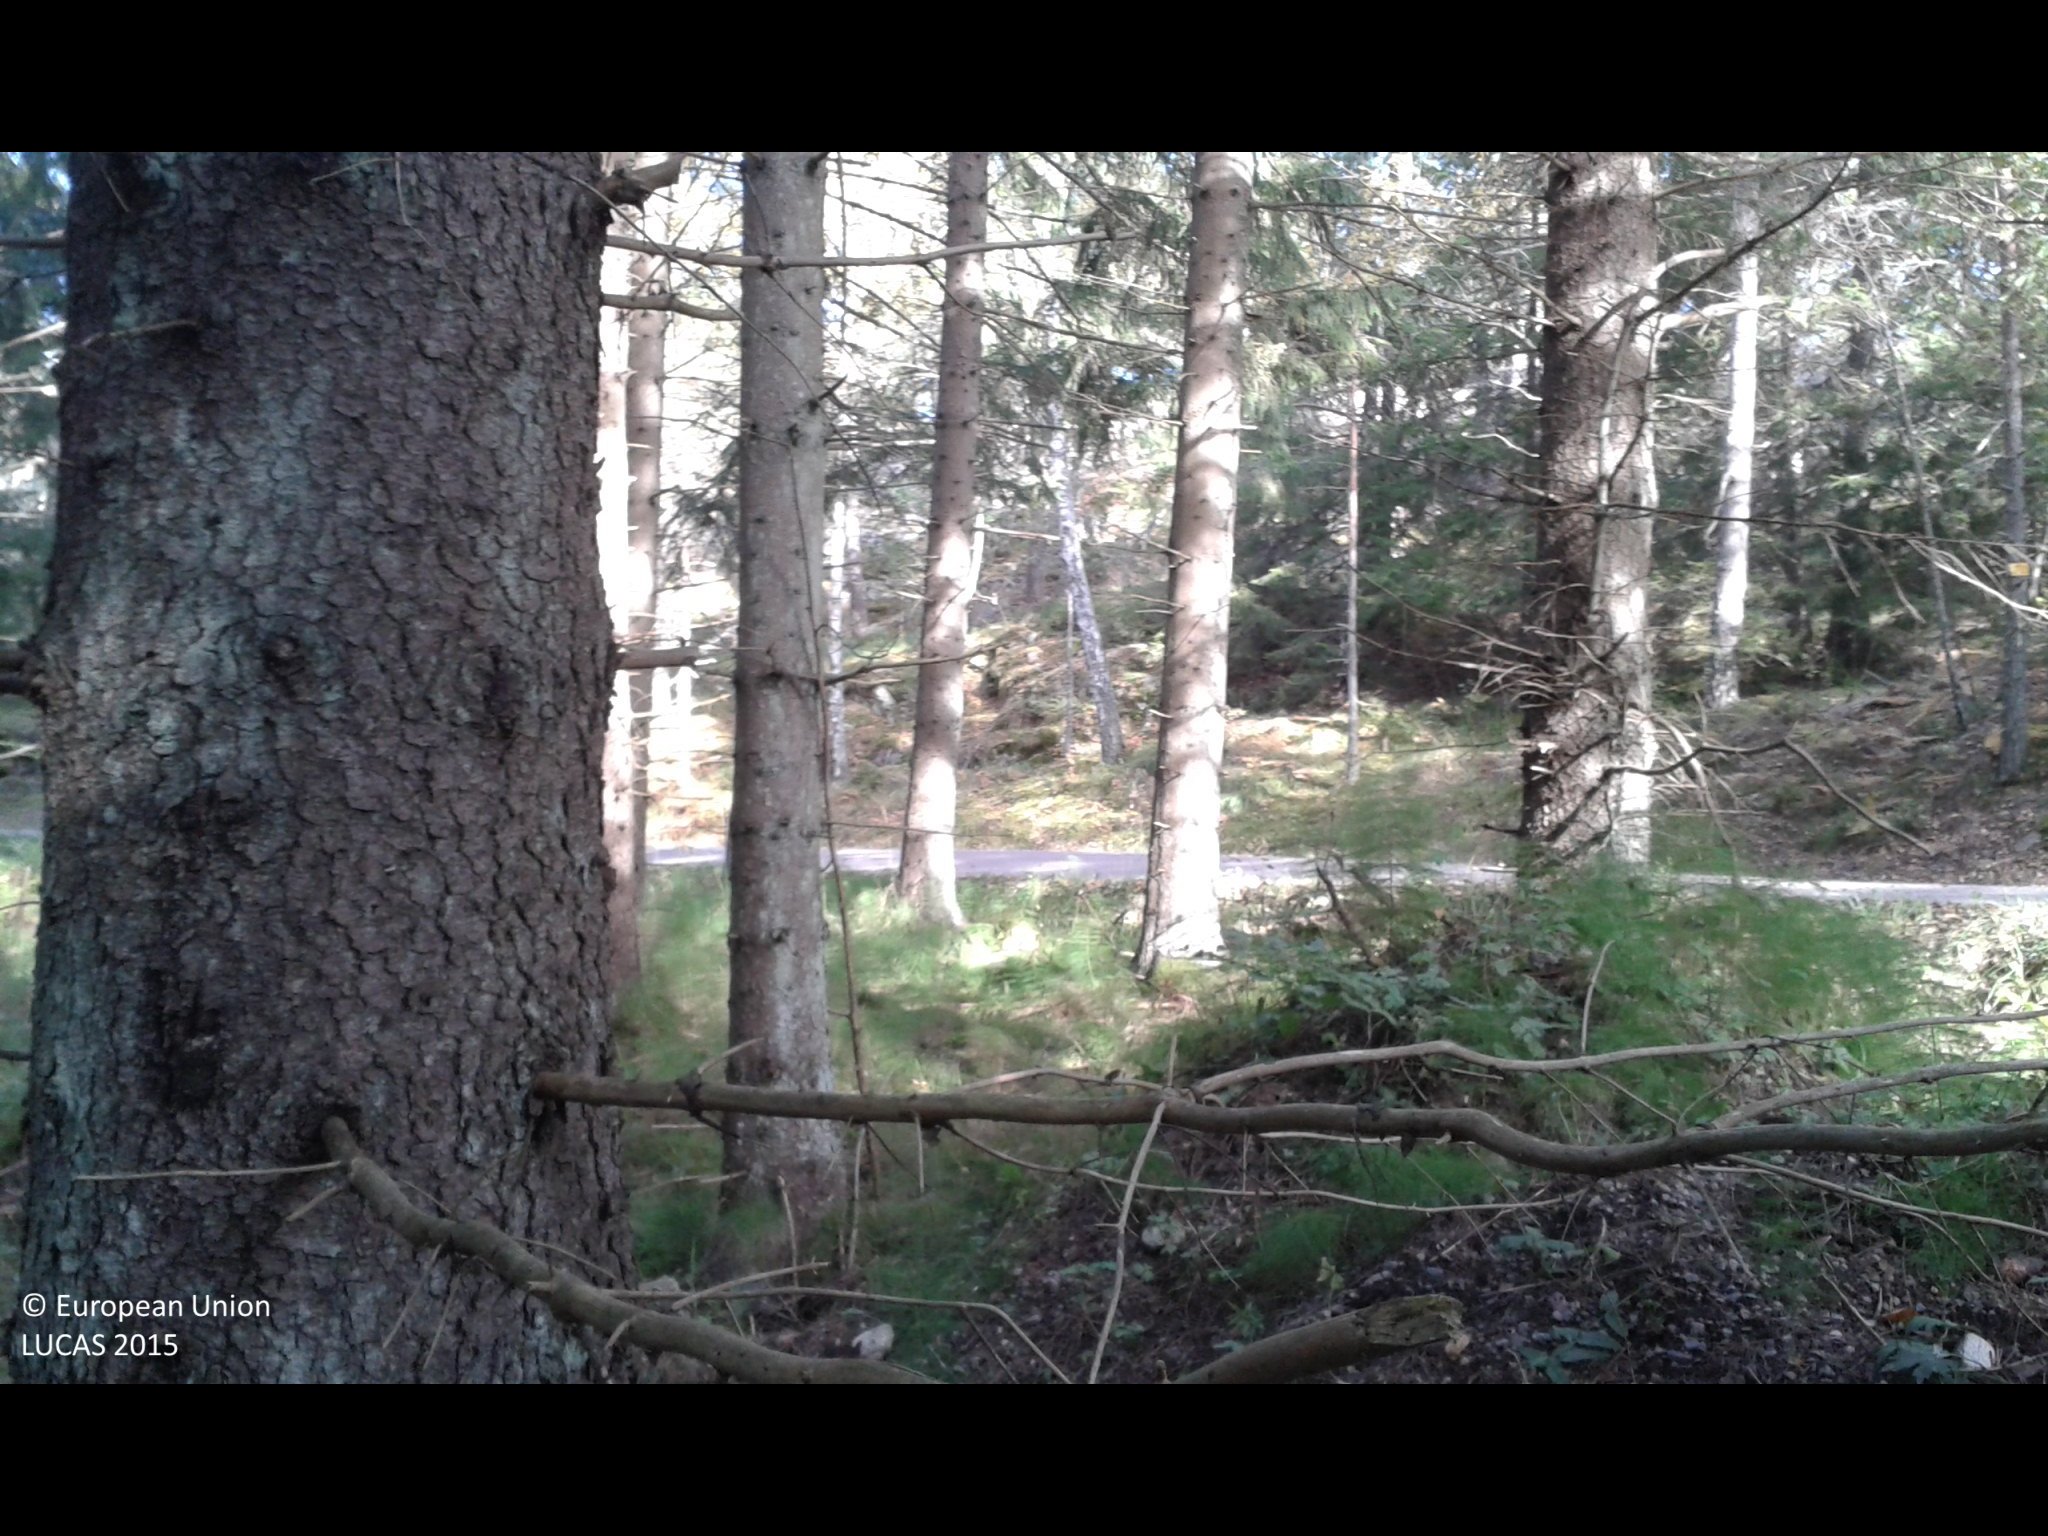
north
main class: Woodland
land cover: Spruce dominated coniferous woodland
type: boreal forest
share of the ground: > 75 %
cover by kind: coniferous forest trees 80 %, herbaceous plants 20 %
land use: Forestry
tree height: > 5 m
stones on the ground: < 10 %
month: October
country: SE
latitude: 58.9704
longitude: 17.4589
